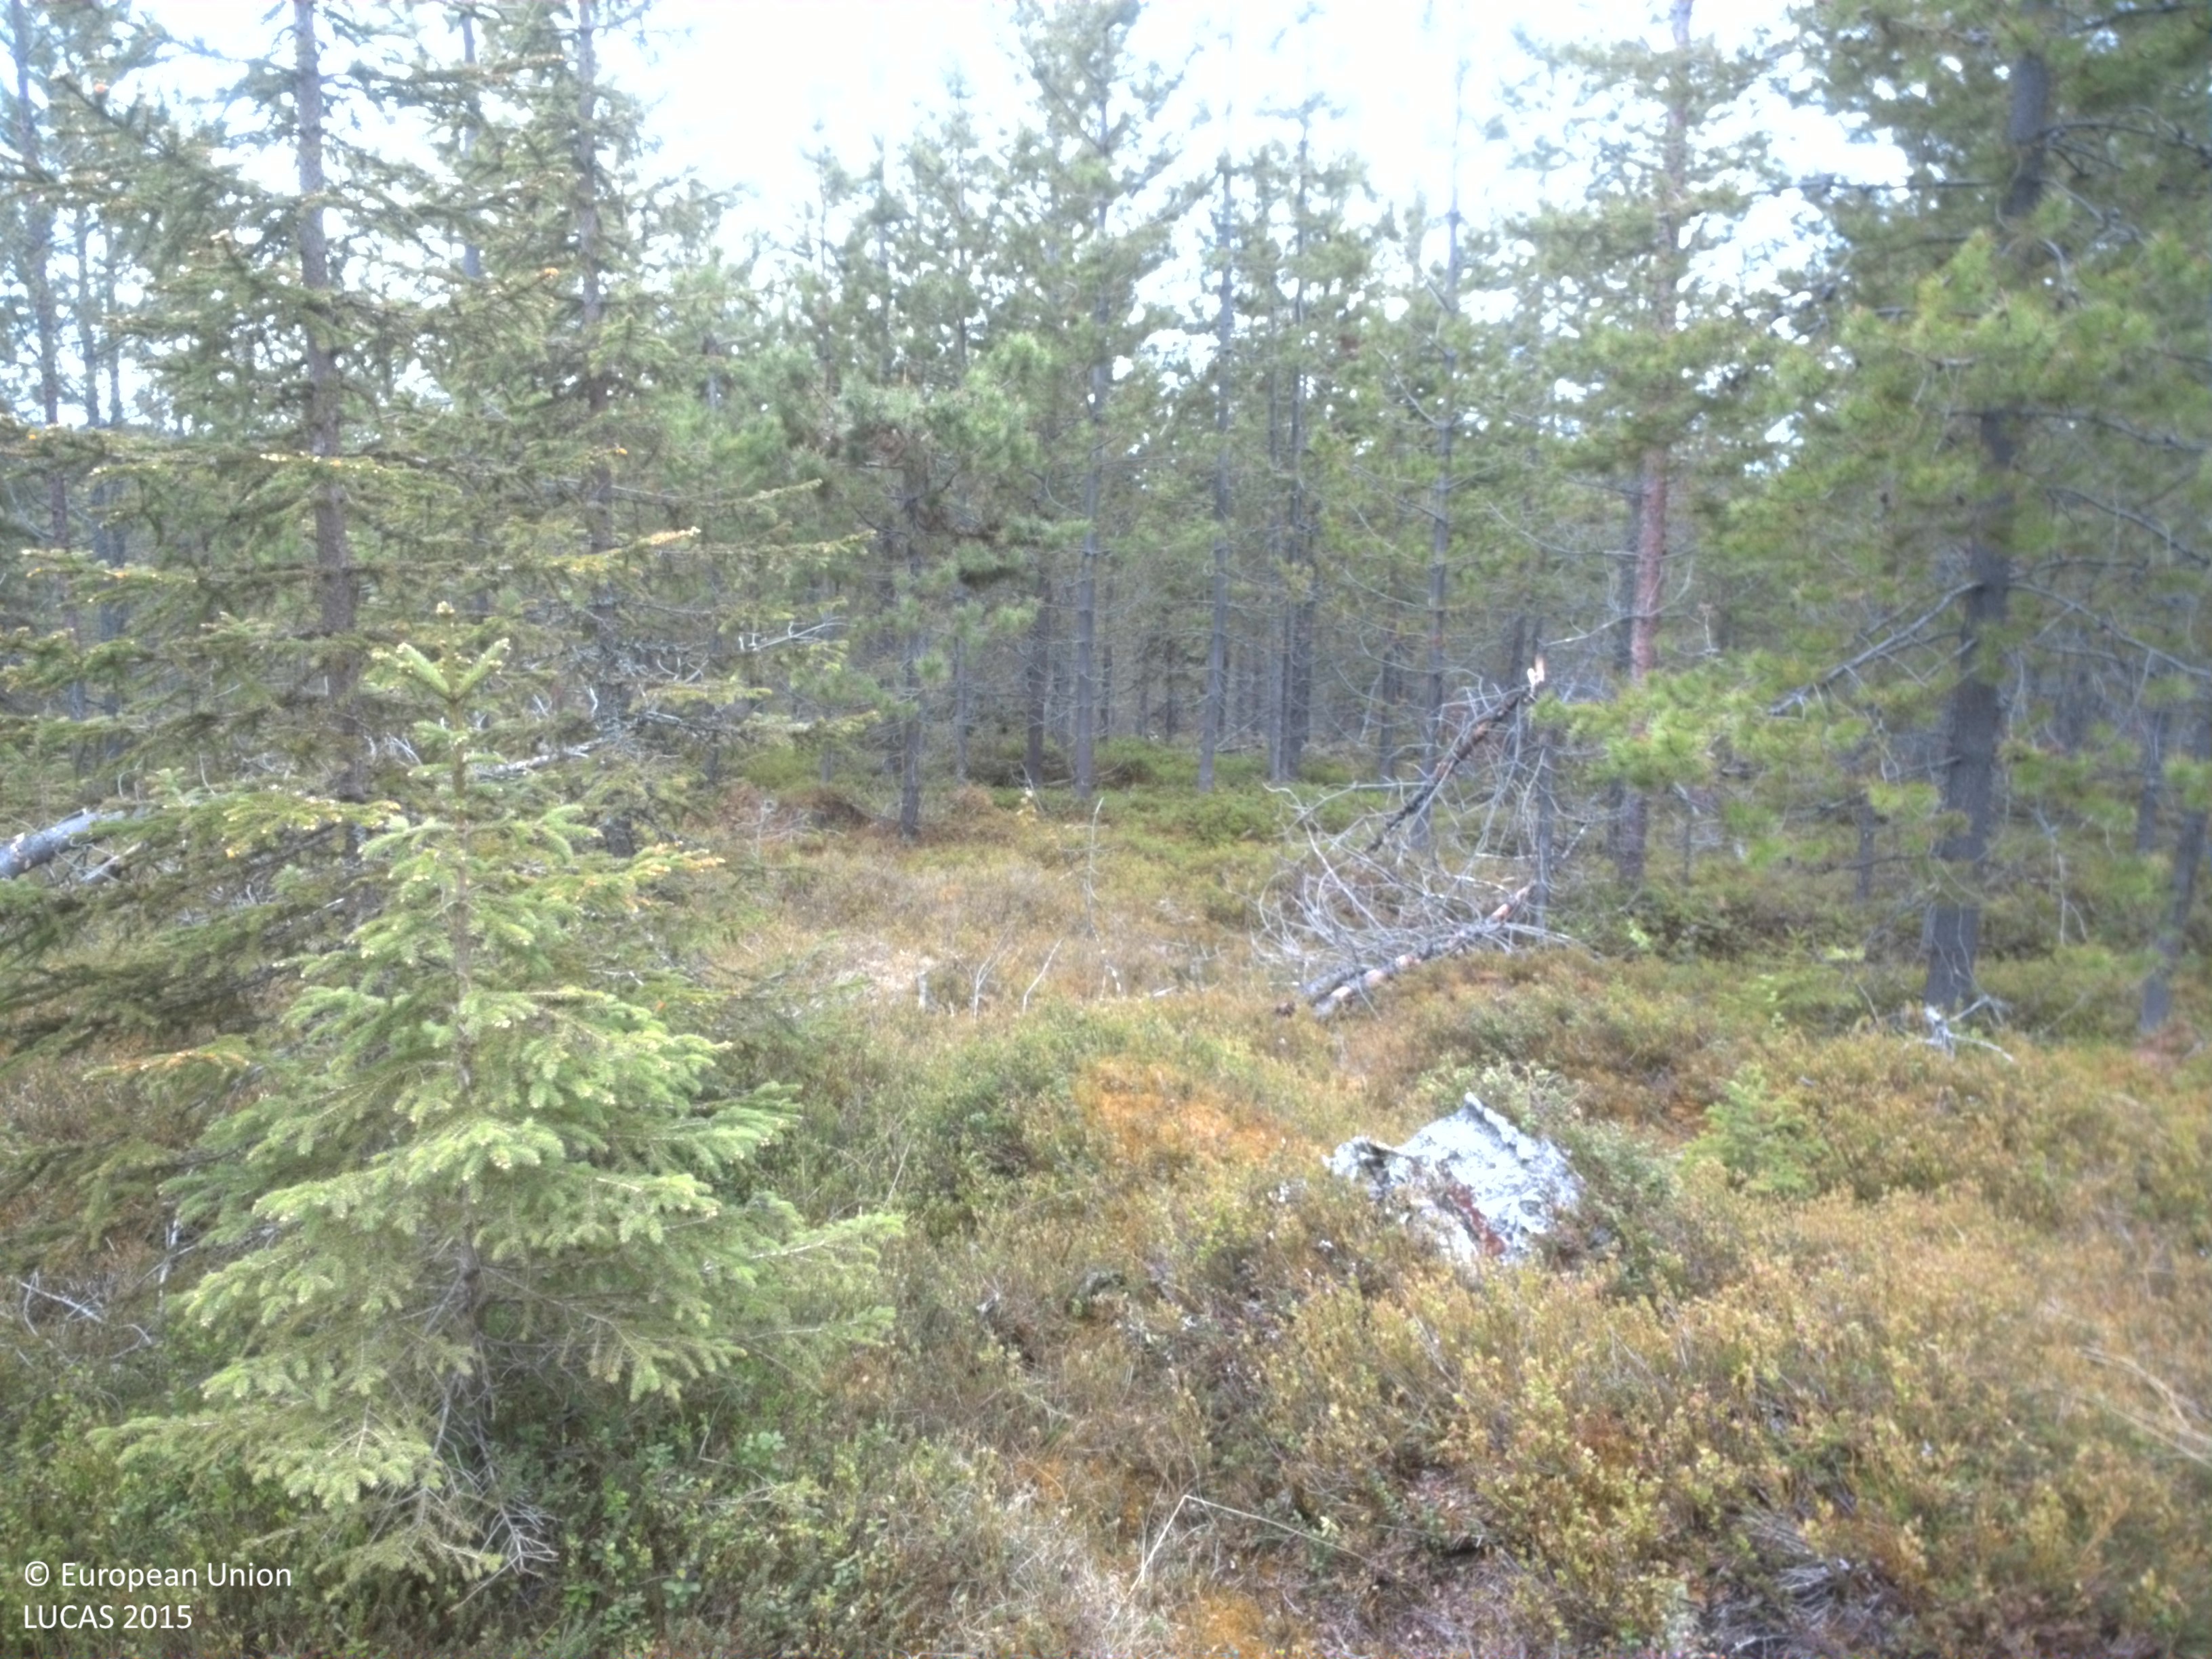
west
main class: Woodland
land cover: Spruce dominated coniferous woodland
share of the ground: 10 - 25 %
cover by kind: herbaceous plants 75 %, coniferous forest trees 10 %, lichens and mosses 10 %, shrubs 5 %
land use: Forestry
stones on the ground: < 10 %
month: June
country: SE
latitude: 66.7877
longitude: 22.4496
